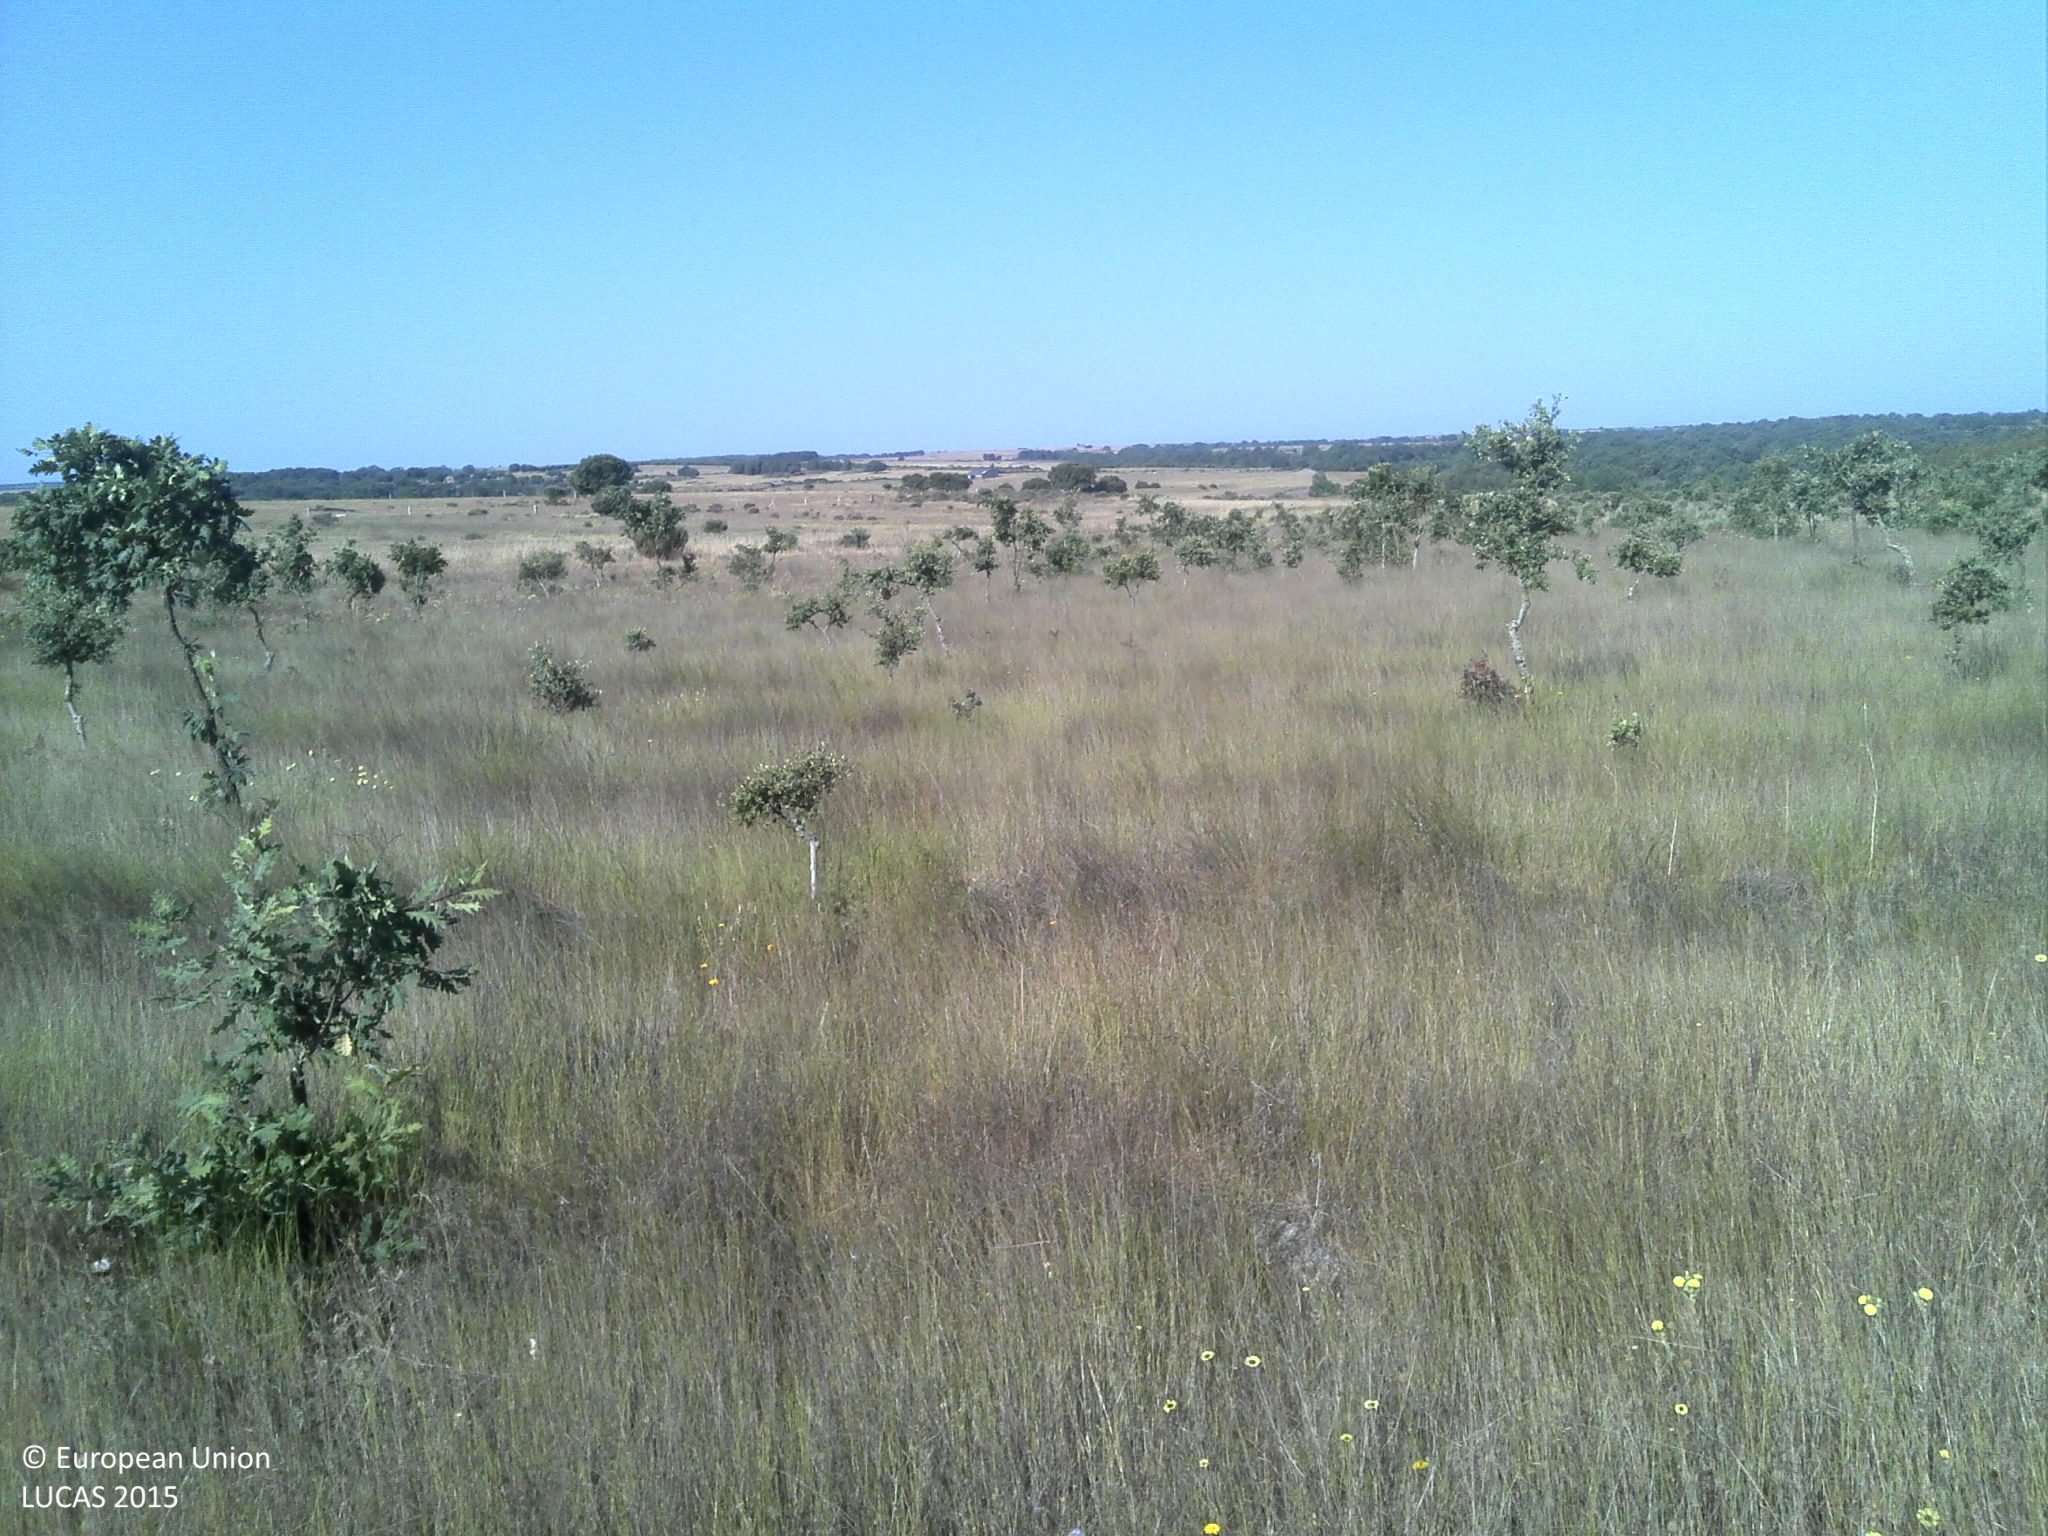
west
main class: Woodland
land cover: Broadleaved woodland
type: acidophilous oak and oak-birch forest
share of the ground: 10 - 25 %
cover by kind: herbaceous plants 60 %, broadleaved forest trees 25 %, unconsolidated bare surface 15 %
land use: Forestry
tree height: < 5 m
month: June
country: PT
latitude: 40.5878
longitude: -6.8386
